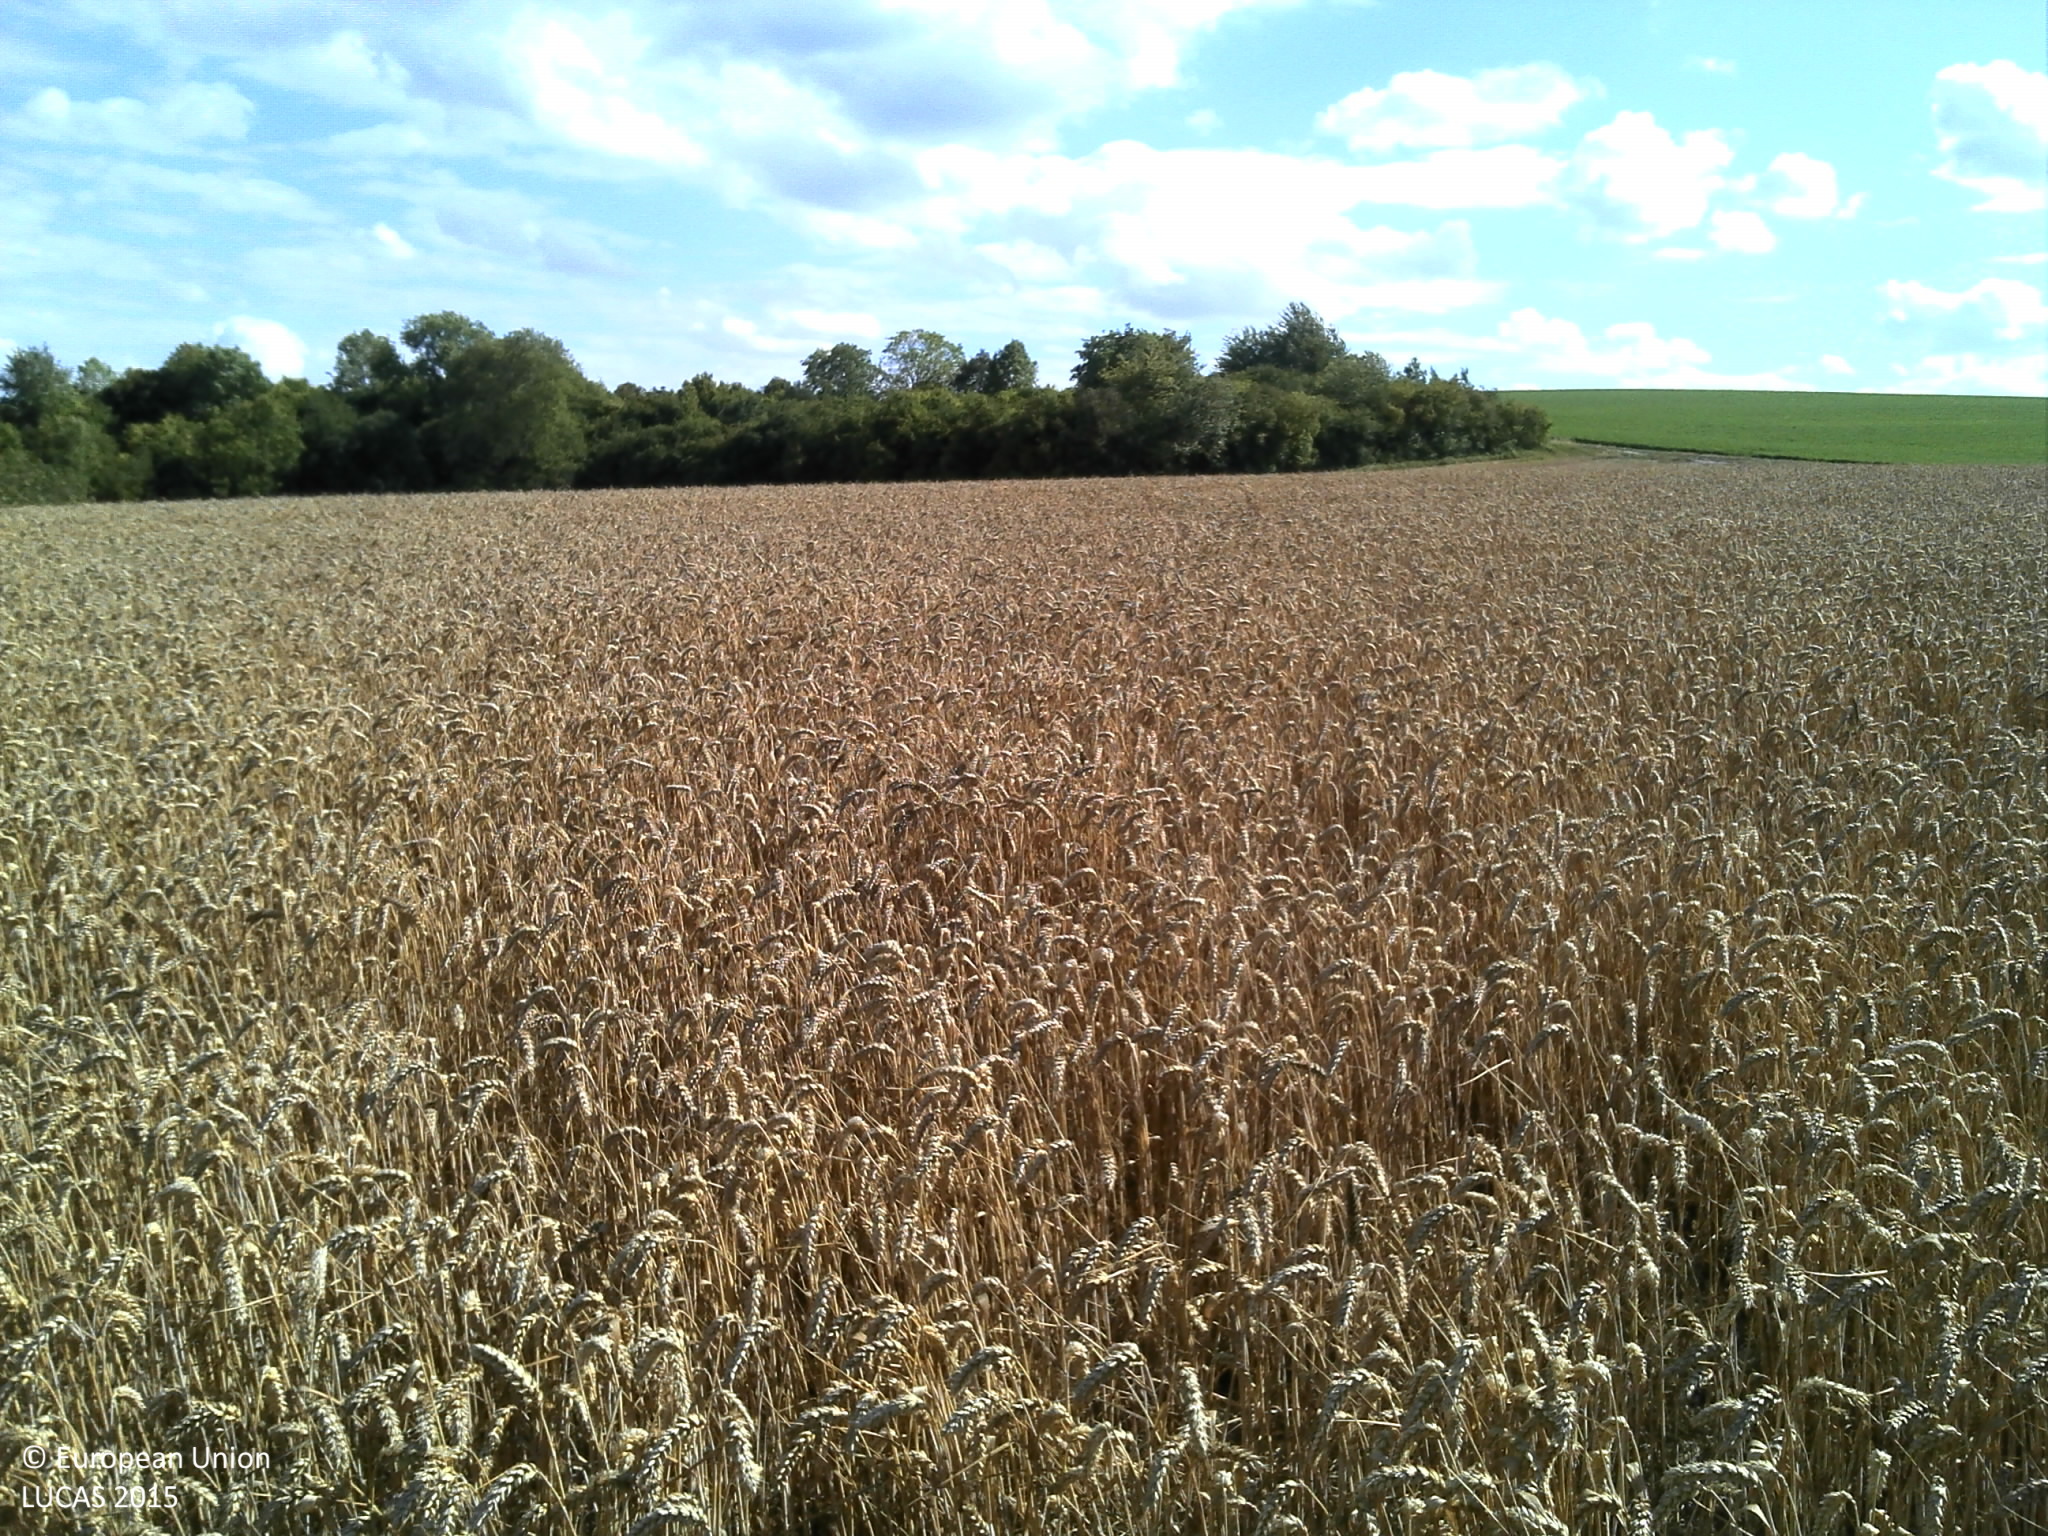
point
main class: Cropland
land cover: Common wheat
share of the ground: > 75 %
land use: Agriculture (excluding fallow land and kitchen gardens)
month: July
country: FR
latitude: 49.2657
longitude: 4.6511
